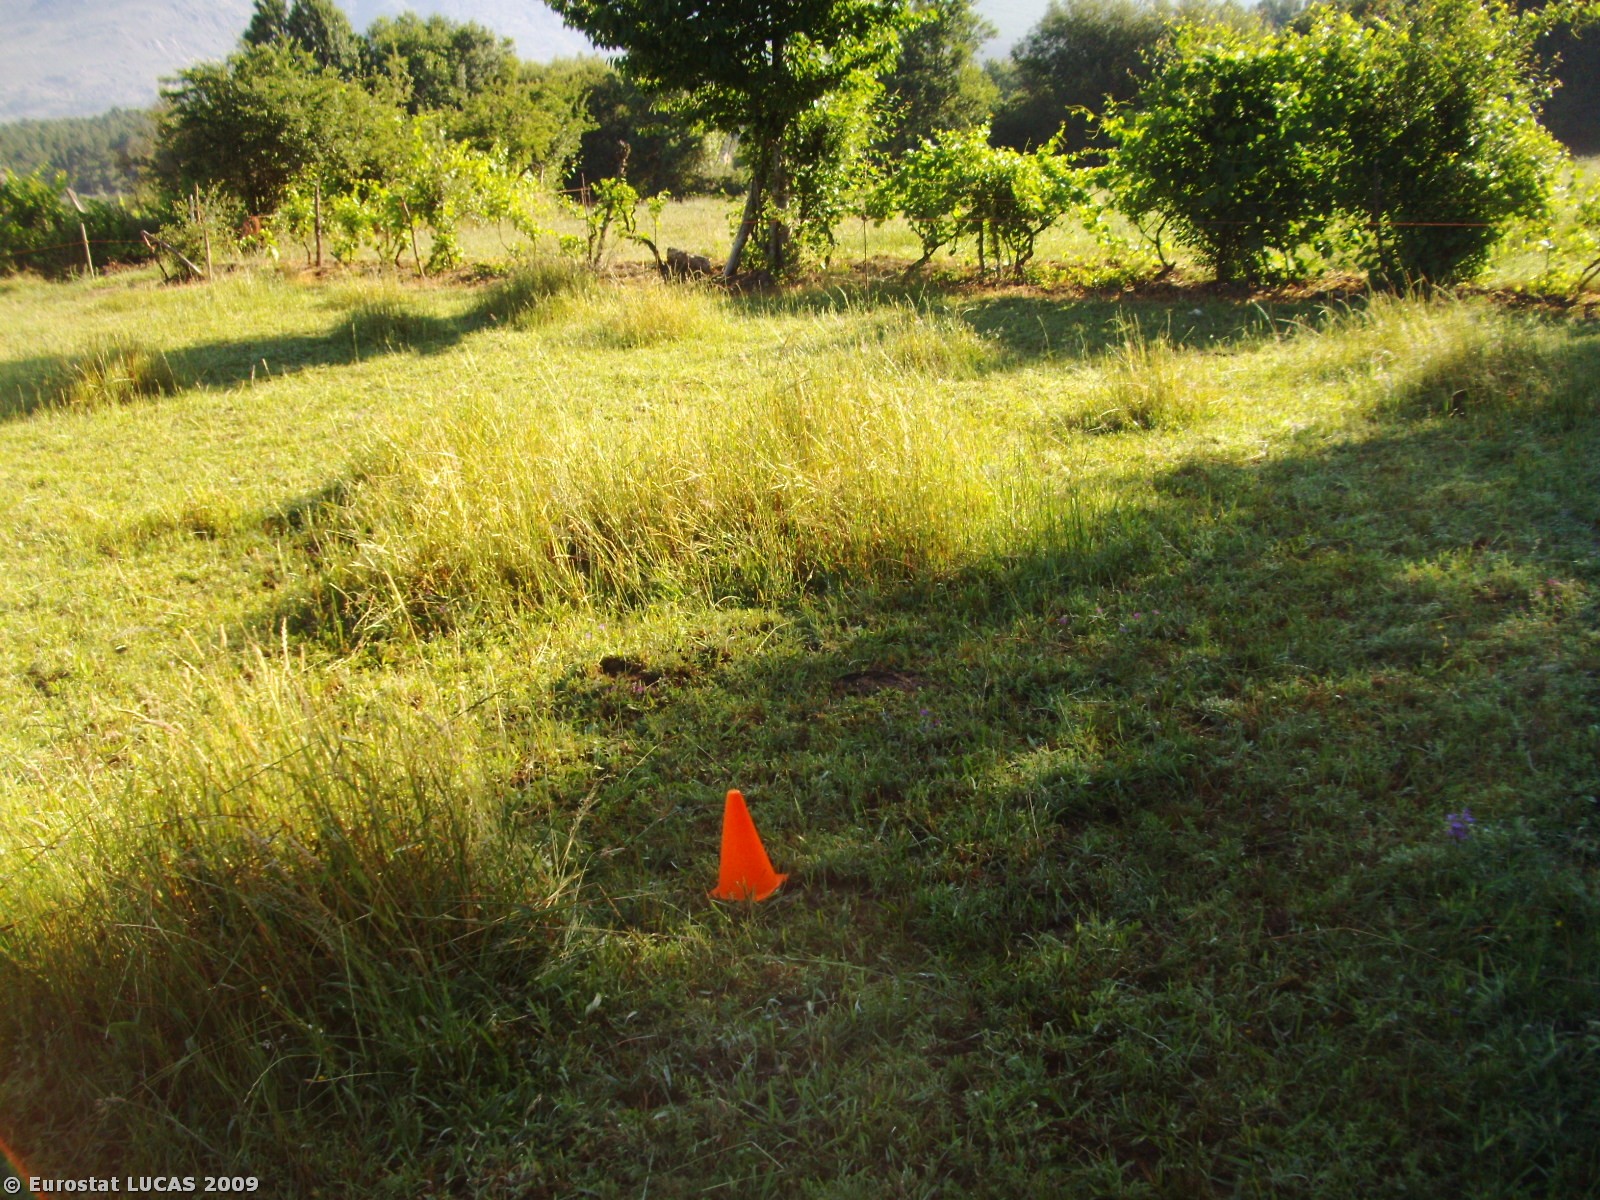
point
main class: Cropland
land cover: Temporary grasslands
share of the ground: > 75 %
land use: Agriculture (excluding fallow land and kitchen gardens)
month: July
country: PT
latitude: 40.2339
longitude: -7.5860
